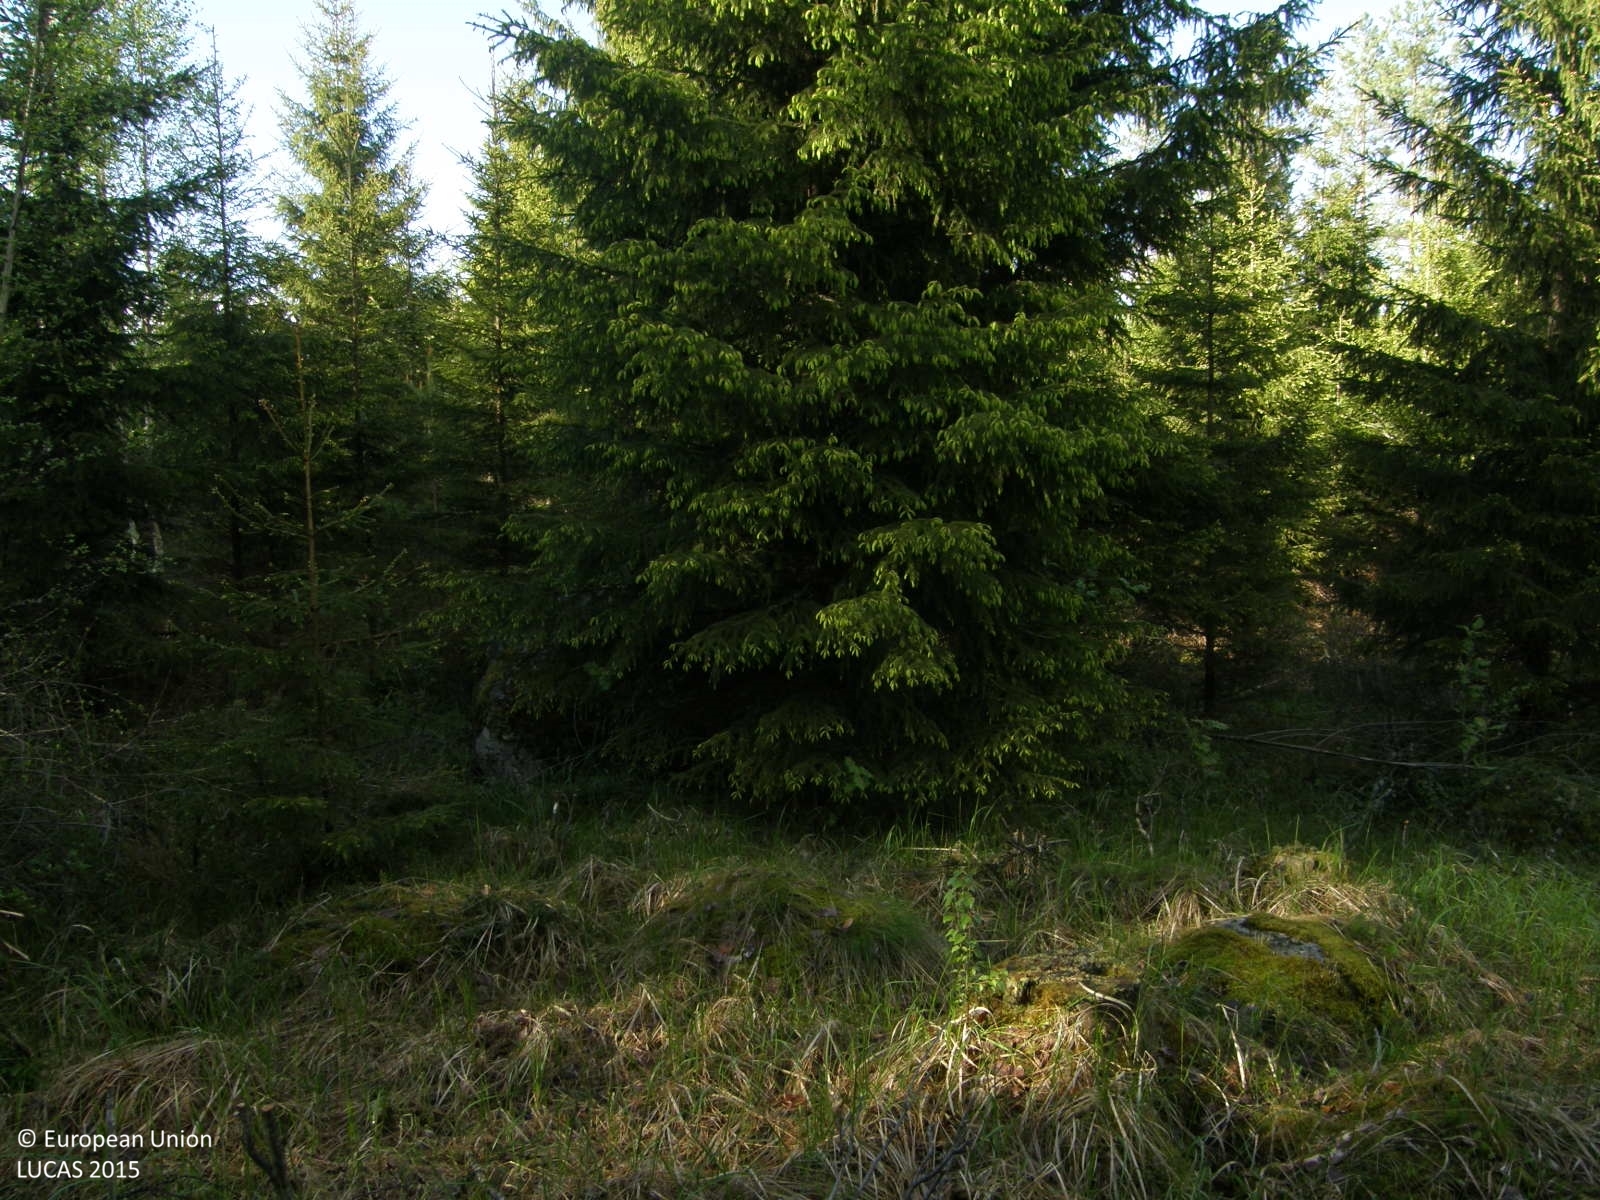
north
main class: Woodland
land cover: Spruce dominated mixed woodland
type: boreal forest
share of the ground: > 75 %
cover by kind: coniferous forest trees 50 %, broadleaved forest trees 25 %, herbaceous plants 25 %
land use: Forestry
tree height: > 5 m
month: June
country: FI
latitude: 62.0071
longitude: 21.7185
